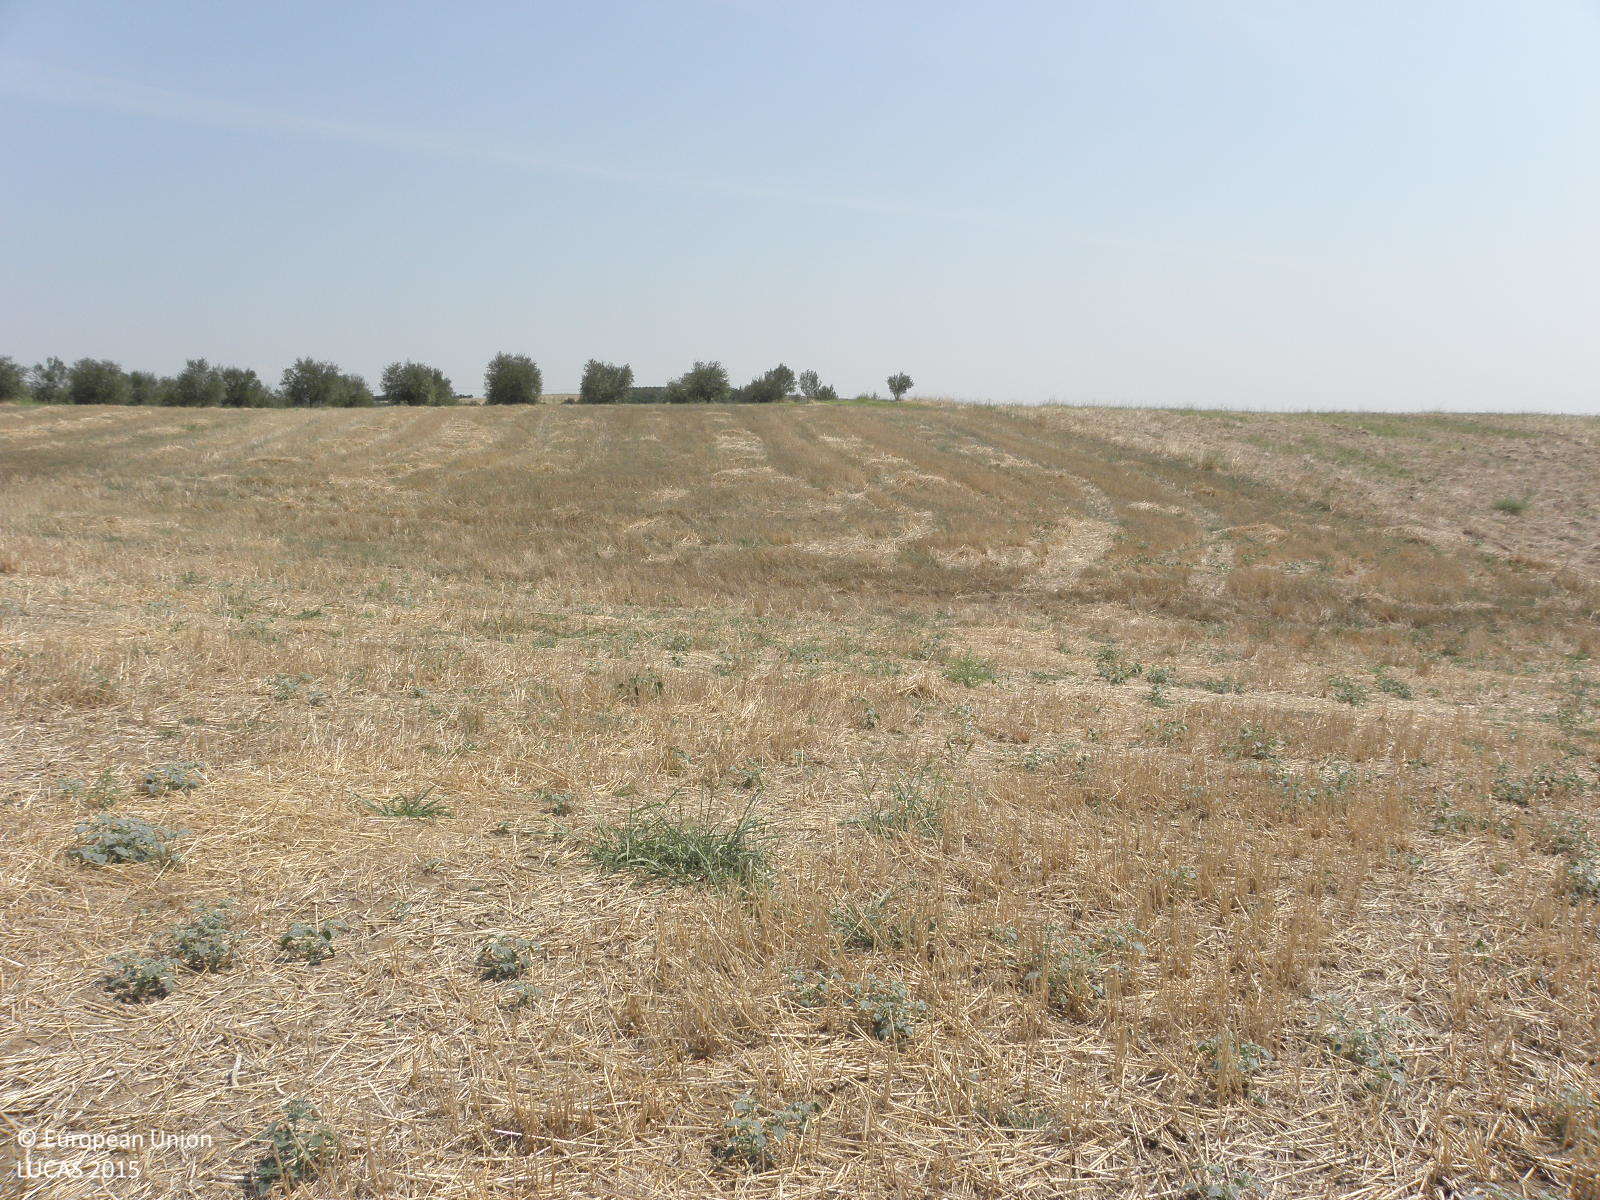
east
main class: Cropland
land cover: Durum wheat
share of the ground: > 75 %
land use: Agriculture (excluding fallow land and kitchen gardens)
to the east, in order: Durum wheat; Olive groves; Tracks; Grass margins; Olive groves; Shrubland with sparse tree cover; Durum wheat; Shrubland with sparse tree cover; Grass margins; Tracks; Shrubland with sparse tree cover
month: August
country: GR
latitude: 40.5246
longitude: 22.5016
